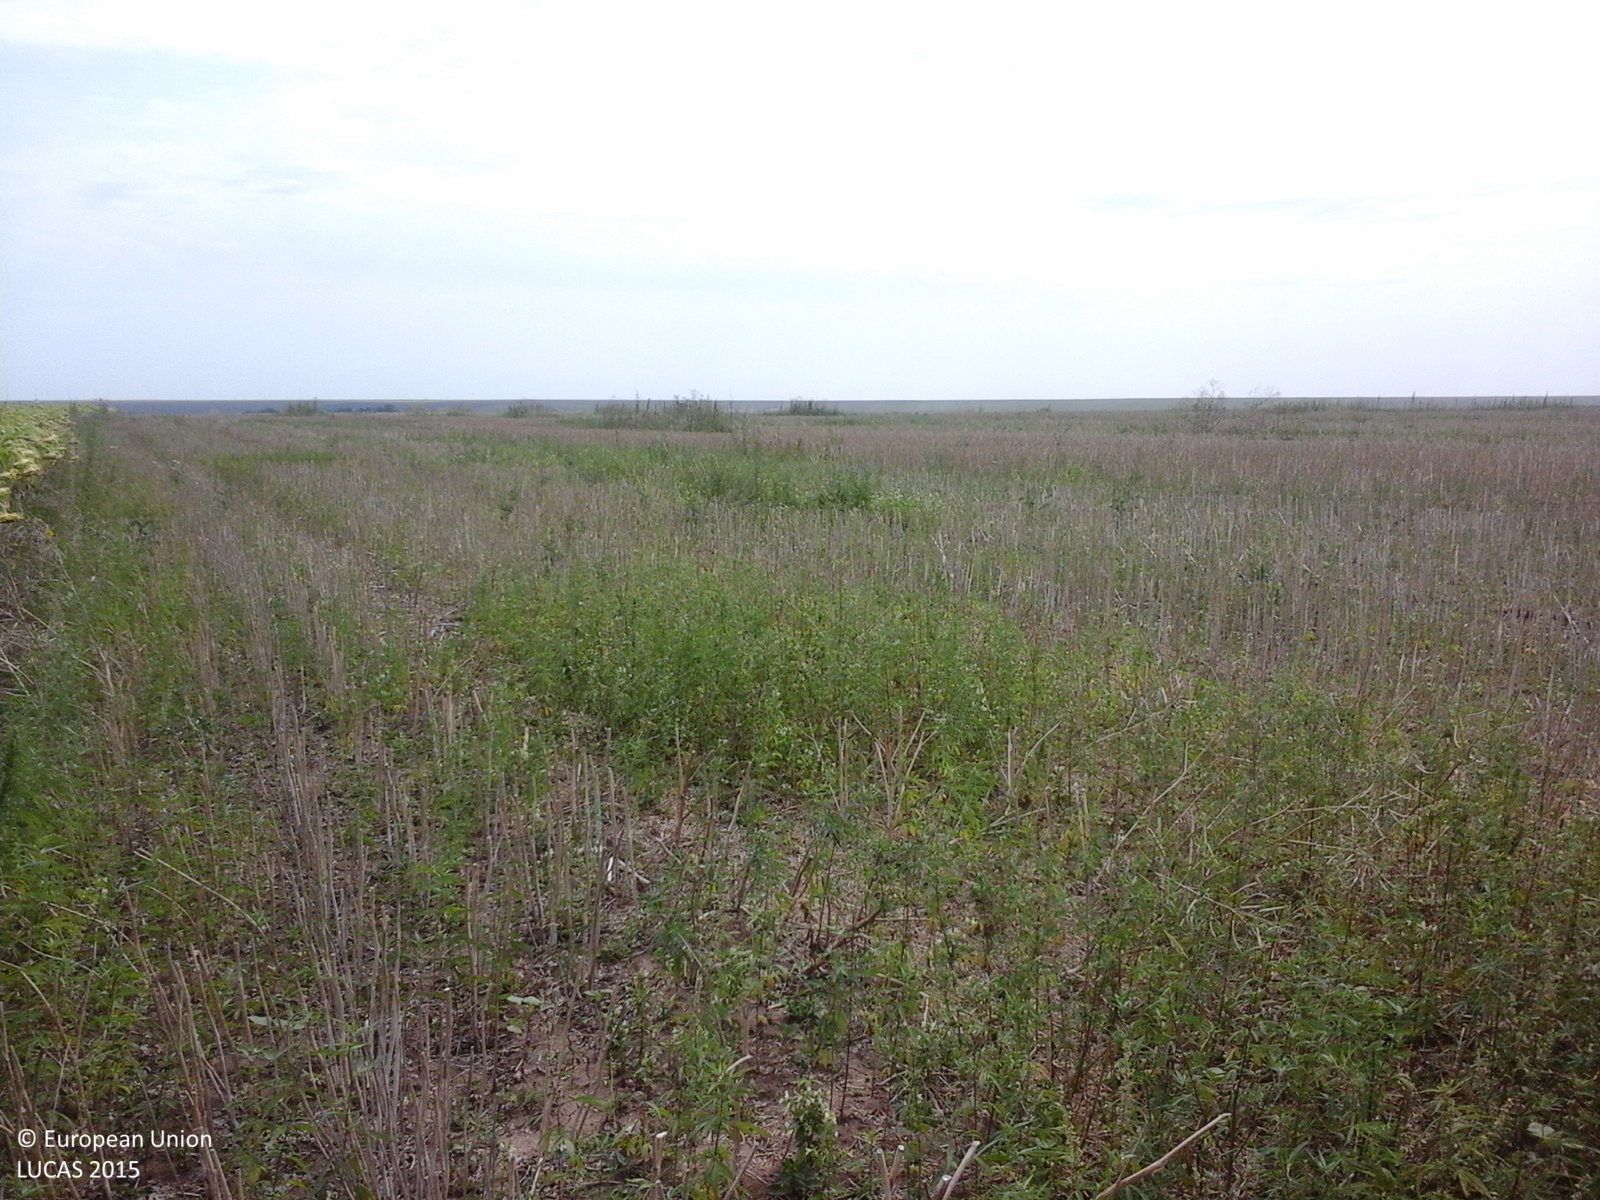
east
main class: Cropland
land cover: Sunflower
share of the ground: > 75 %
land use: Agriculture (excluding fallow land and kitchen gardens)
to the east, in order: Sunflower
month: August
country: RO
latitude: 43.8444
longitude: 28.0247
